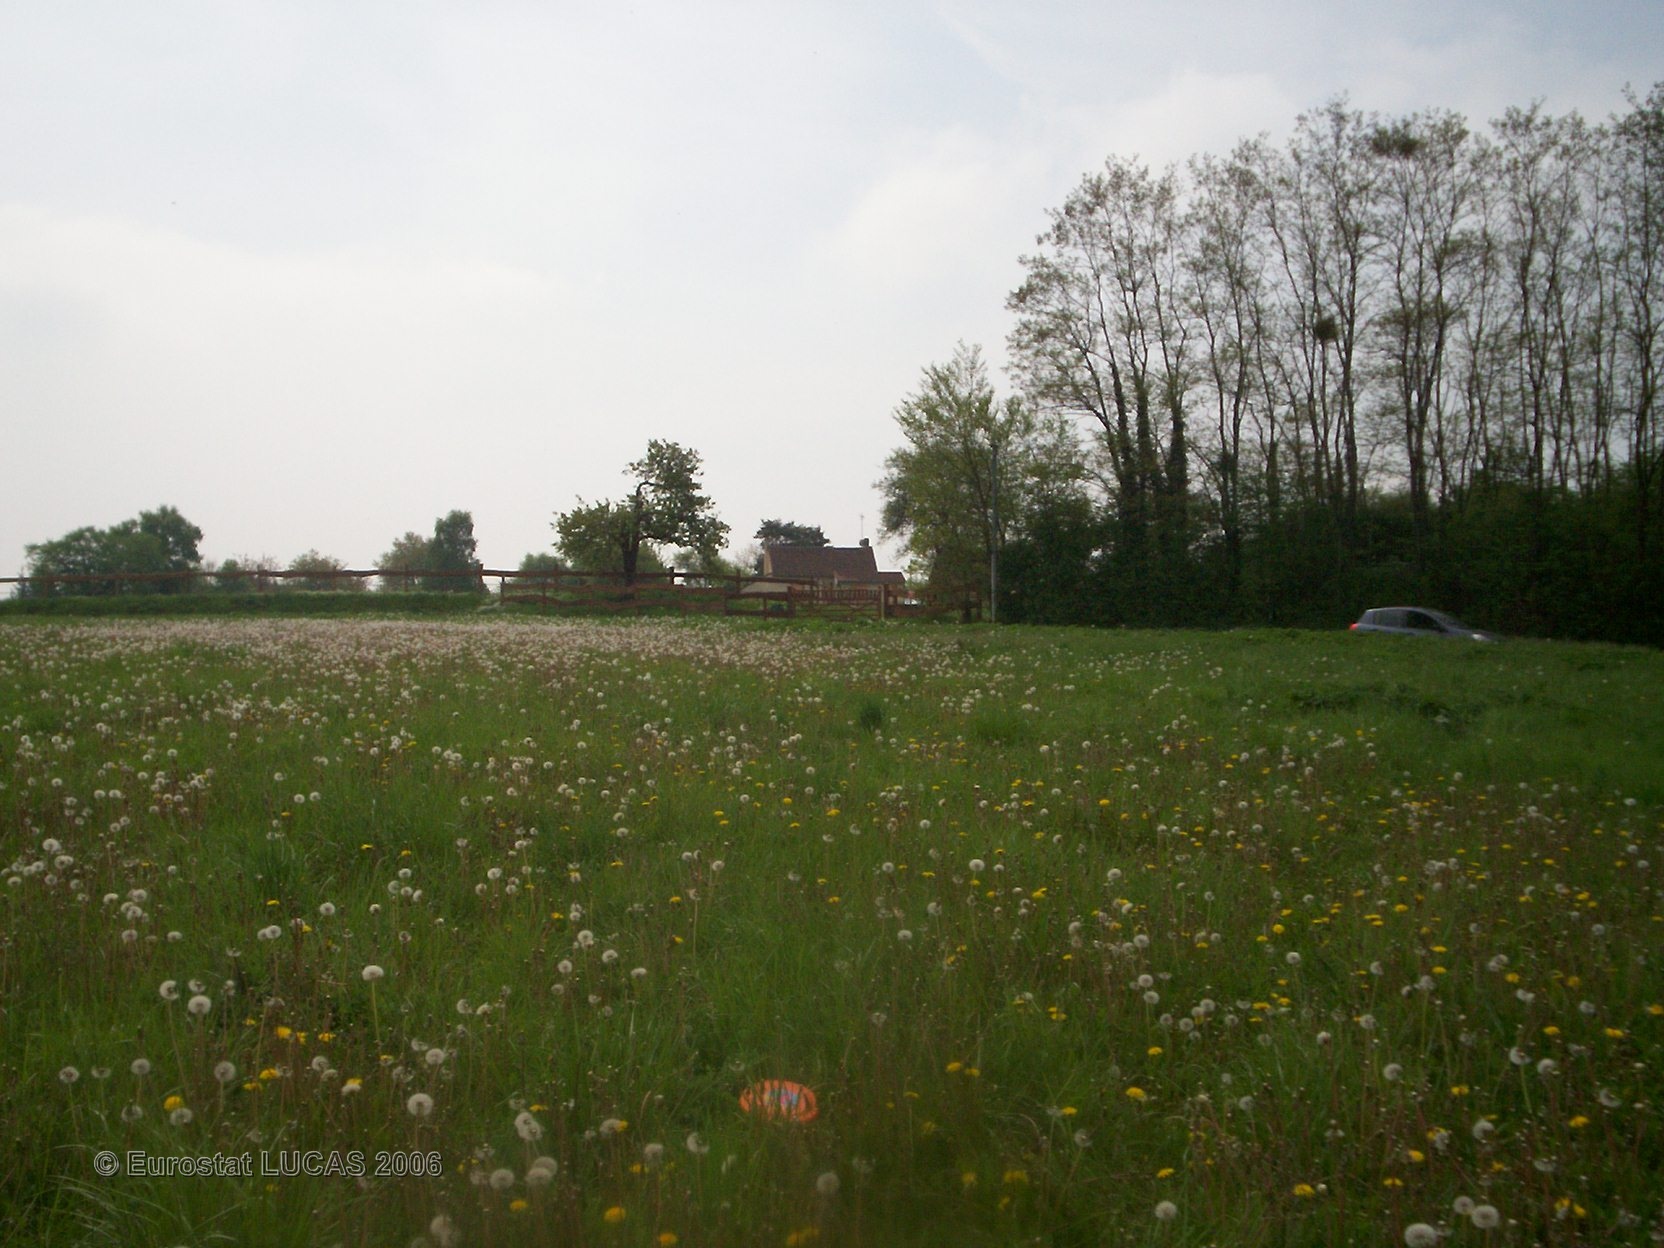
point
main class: Grassland
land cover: Grassland without tree/shrub cover
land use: Fallow land
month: May
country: FR
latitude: 47.9282
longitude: 2.9932
